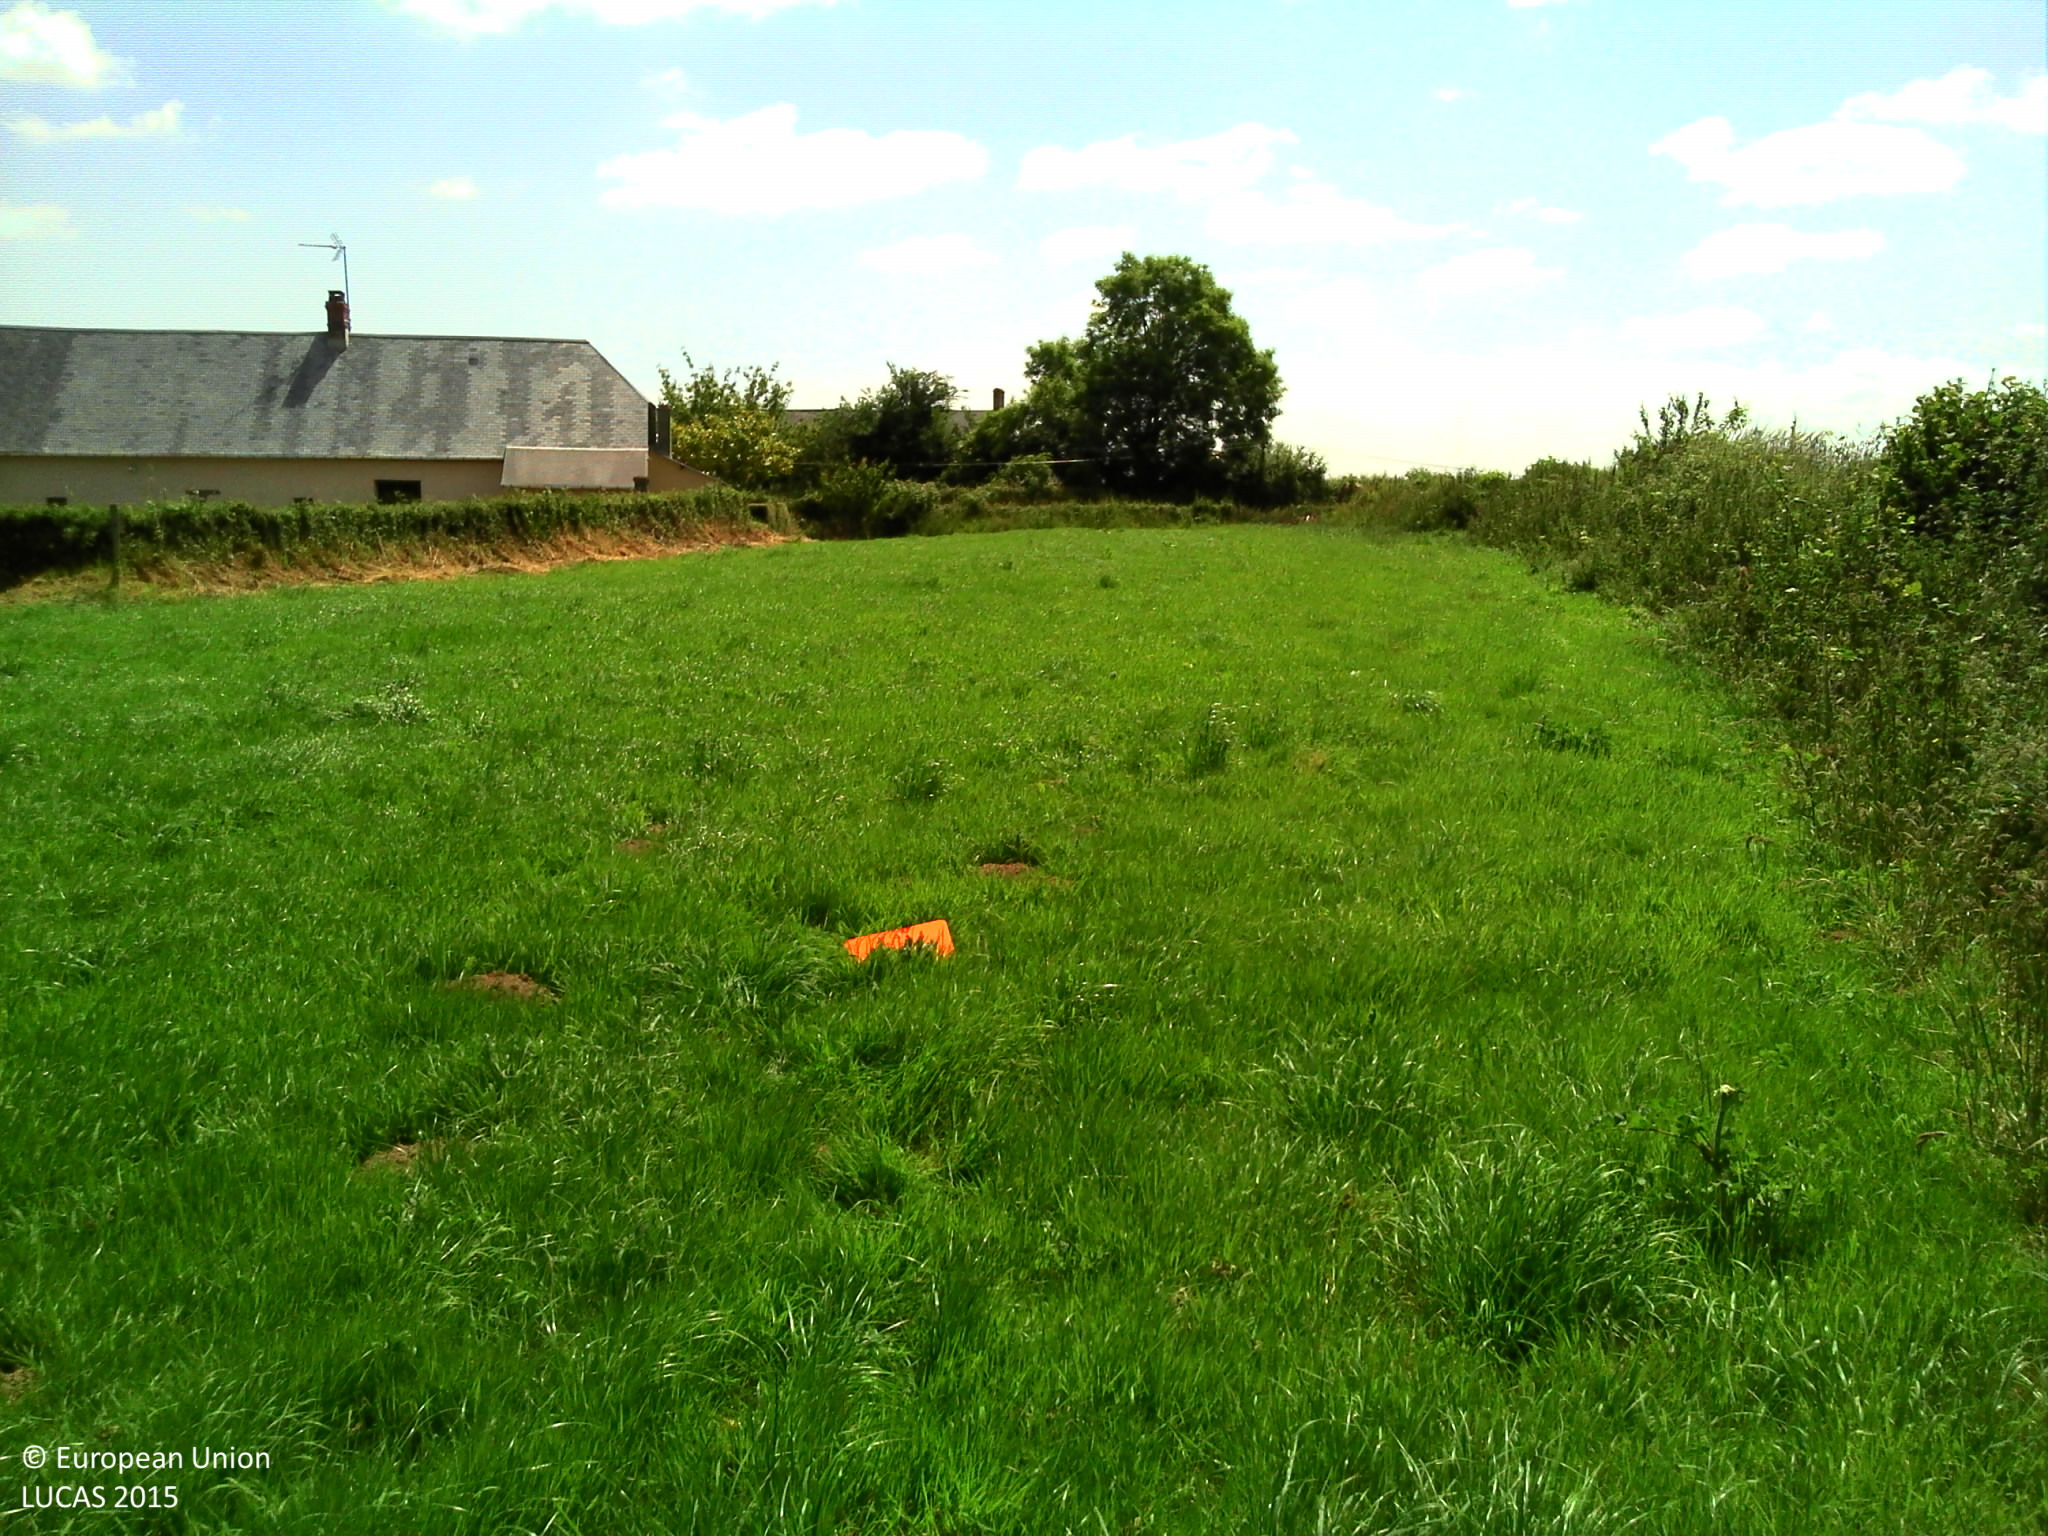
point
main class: Grassland
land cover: Grassland without tree/shrub cover
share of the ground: > 75 %
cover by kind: herbaceous plants 100 %
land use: Agriculture (excluding fallow land and kitchen gardens)
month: June
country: FR
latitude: 49.2639
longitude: -1.4123
